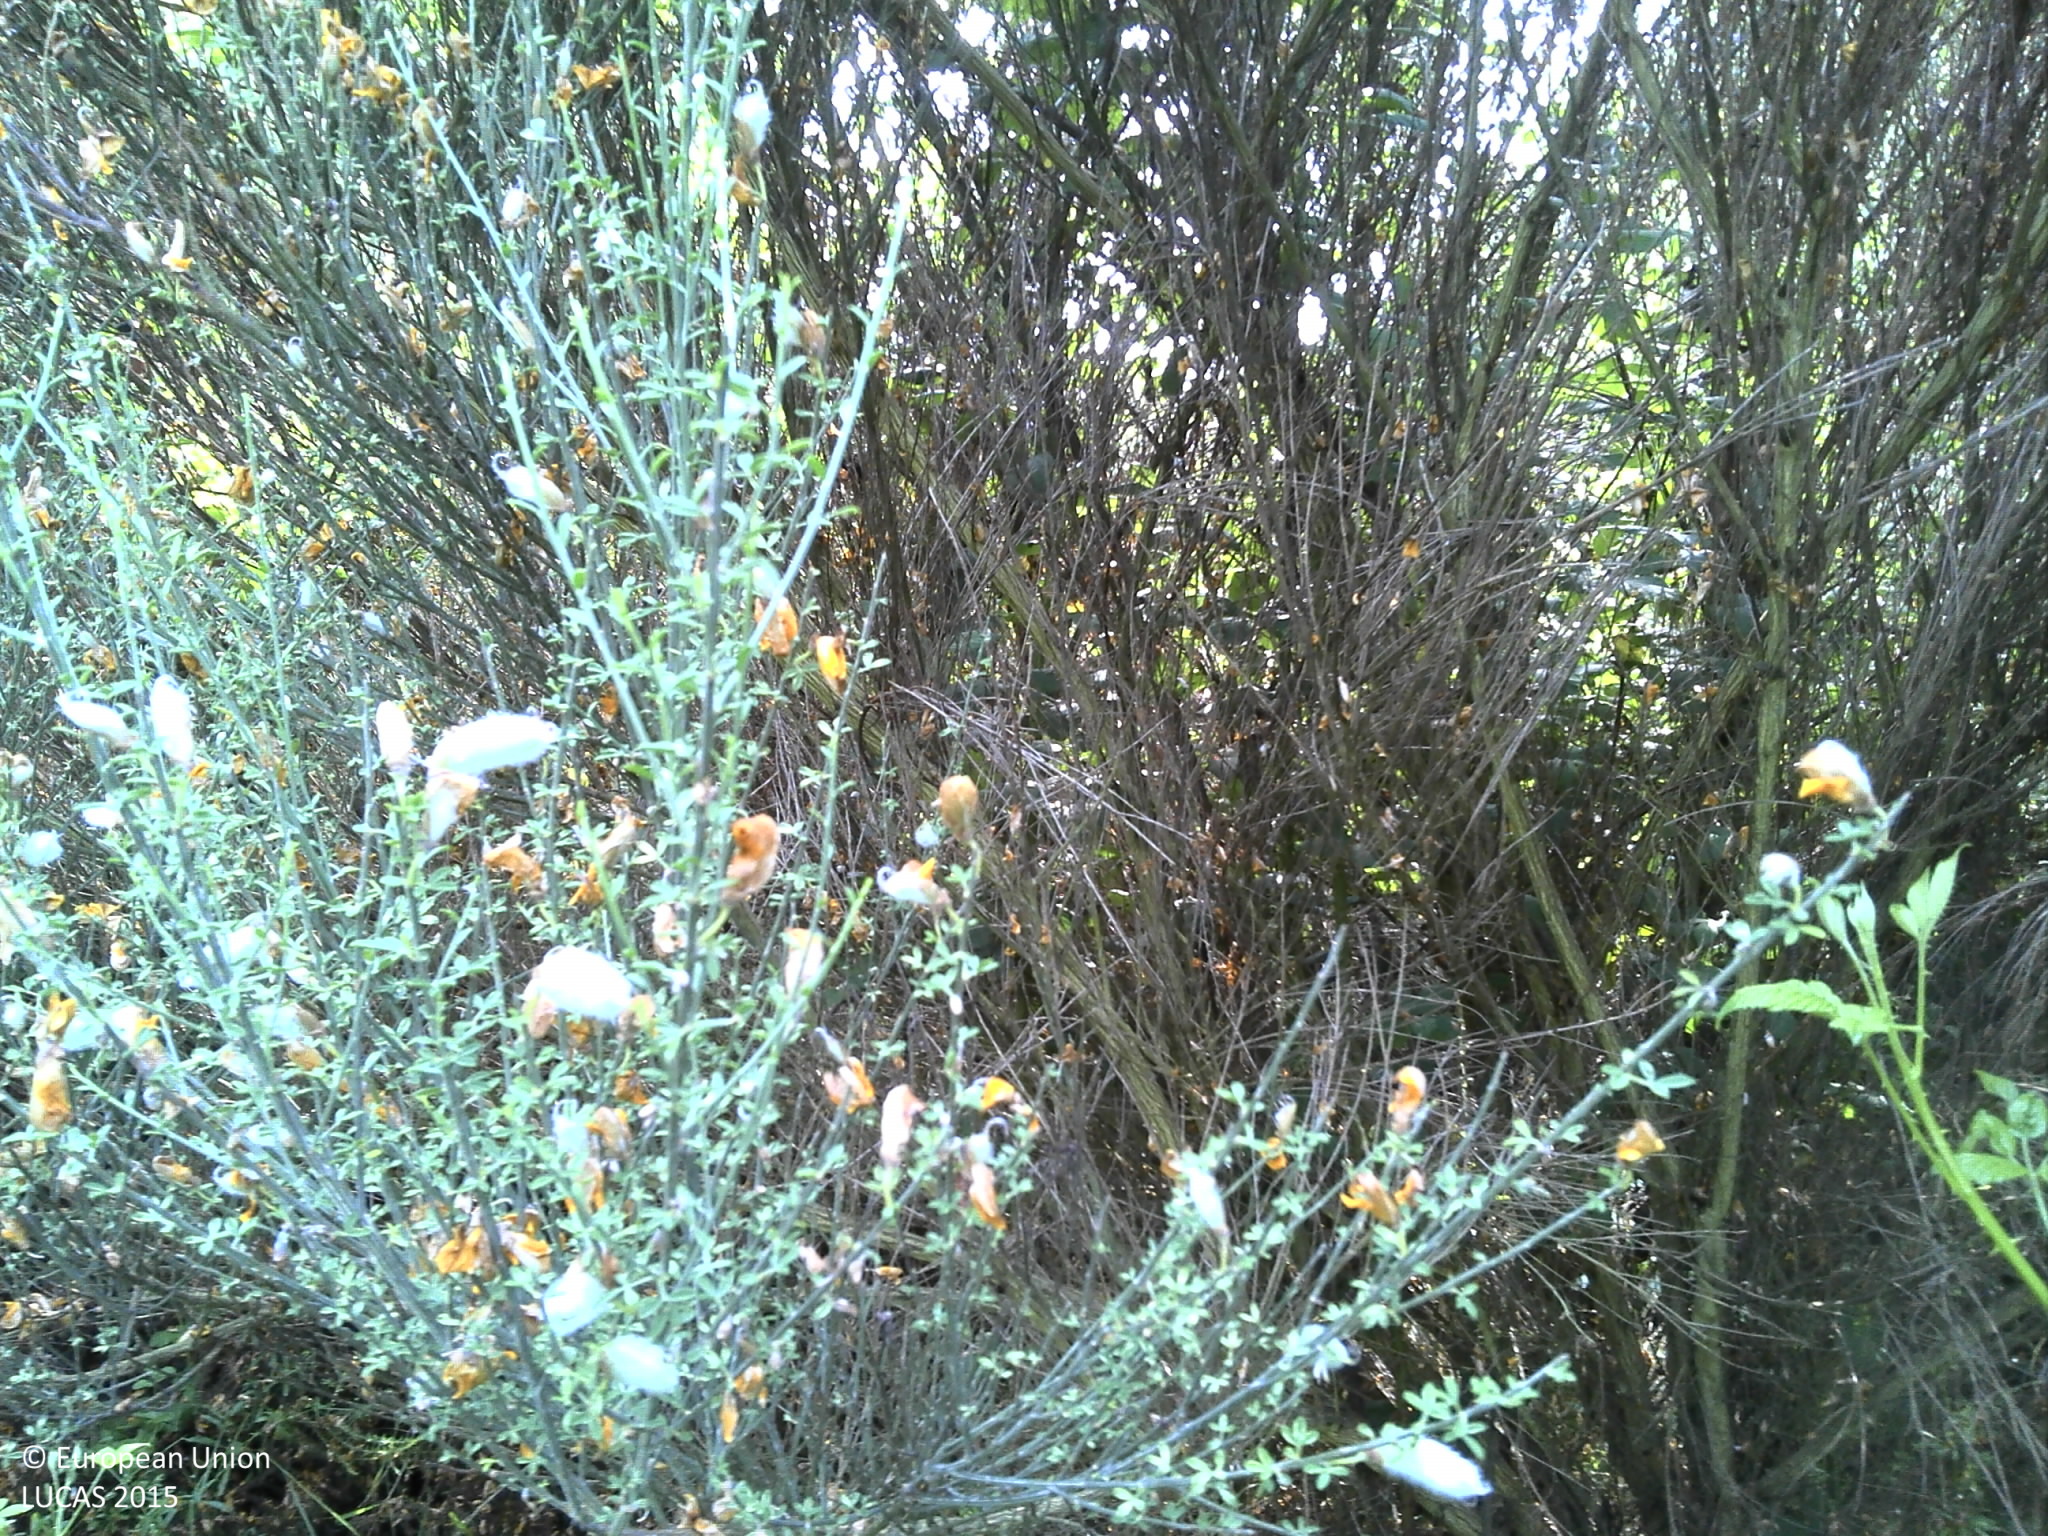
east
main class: Shrubland
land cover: Shrubland with sparse tree cover
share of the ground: > 75 %
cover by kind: shrubs 85 %, herbaceous plants 10 %, broadleaved forest trees 5 %
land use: Semi-natural and natural areas not in use
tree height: > 5 m
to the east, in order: Shrubland with sparse tree cover; Fences; Grass margins; Tracks; Grass margins; Fences; Shrubland with sparse tree cover; Fences; Shruby margins; Tracks; Shruby margins; Dry stone walls; Nuts trees; Shrubland with sparse tree cover; Pine dominated coniferous woodland; Dry stone walls; Shruby margins; Tracks; Shrubland with sparse tree cover; Pine dominated coniferous woodland
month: June
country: PT
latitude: 41.4275
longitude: -7.5132
